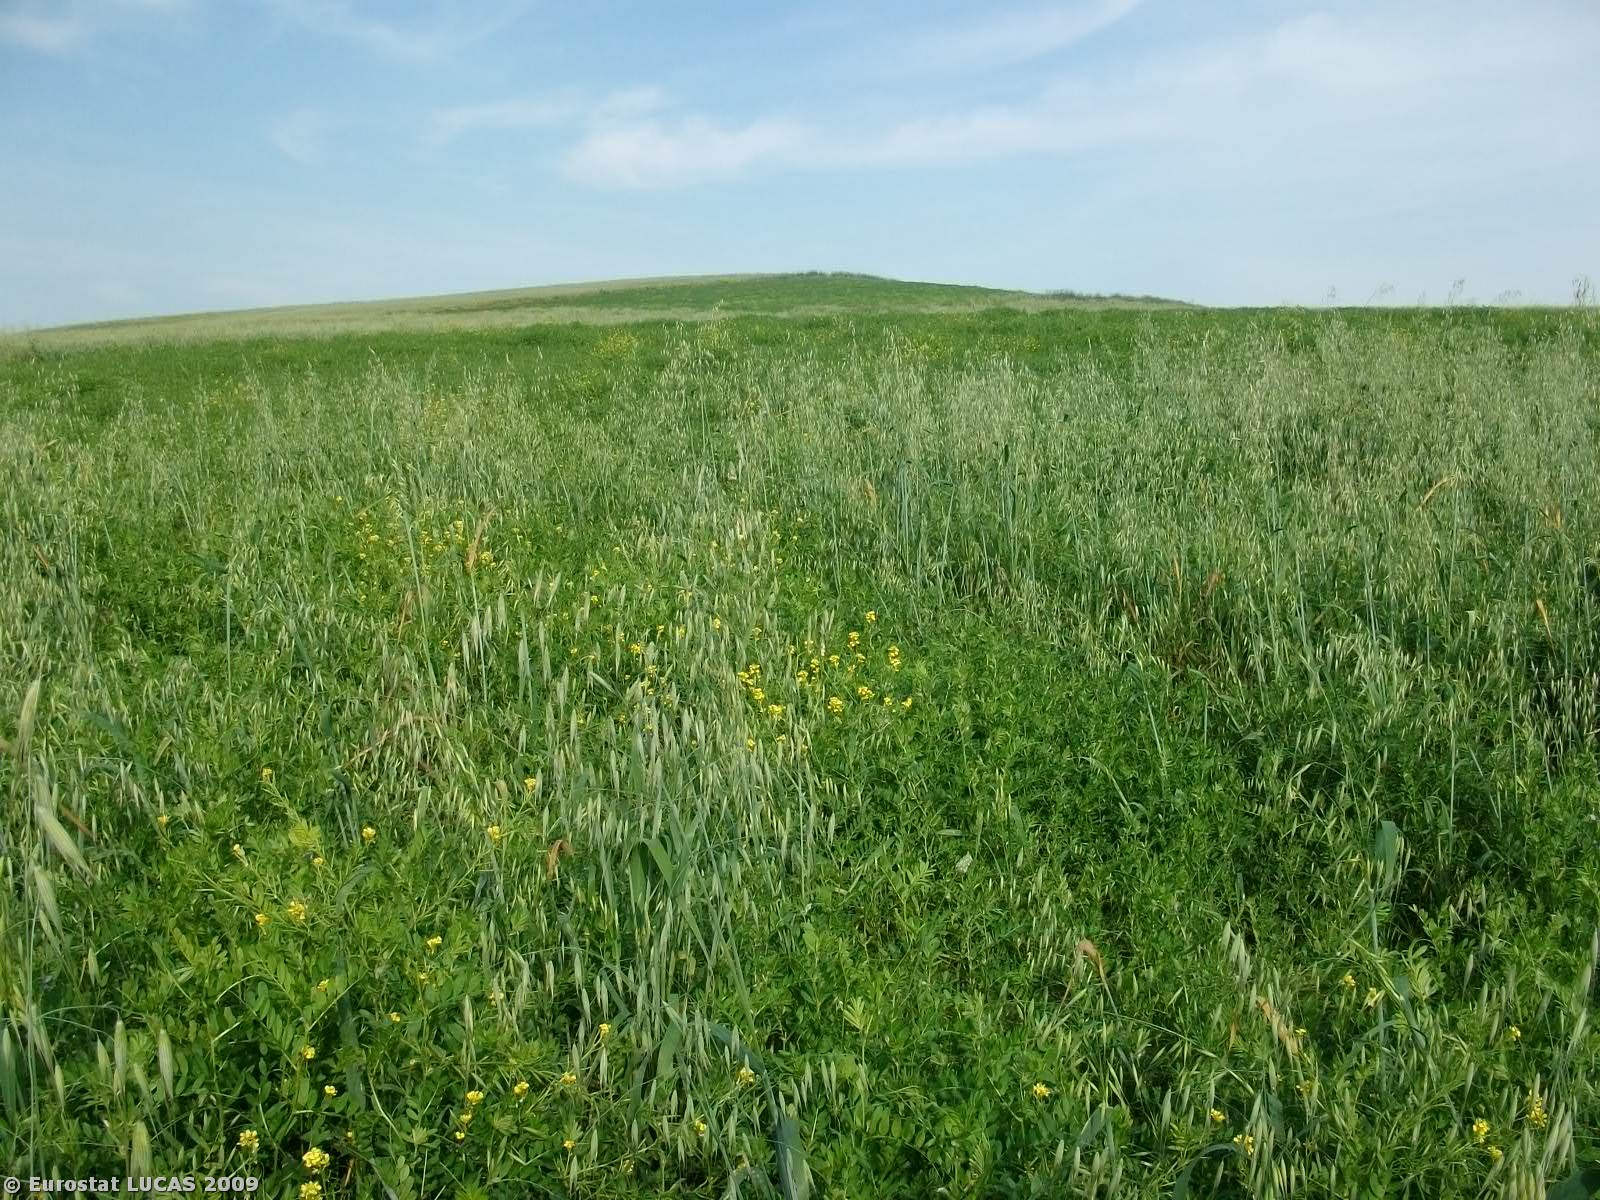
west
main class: Cropland
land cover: Other leguminous and mixtures for fodder
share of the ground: > 75 %
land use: Agriculture (excluding fallow land and kitchen gardens)
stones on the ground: < 10 %
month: May
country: GR
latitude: 39.4249
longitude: 22.3816
